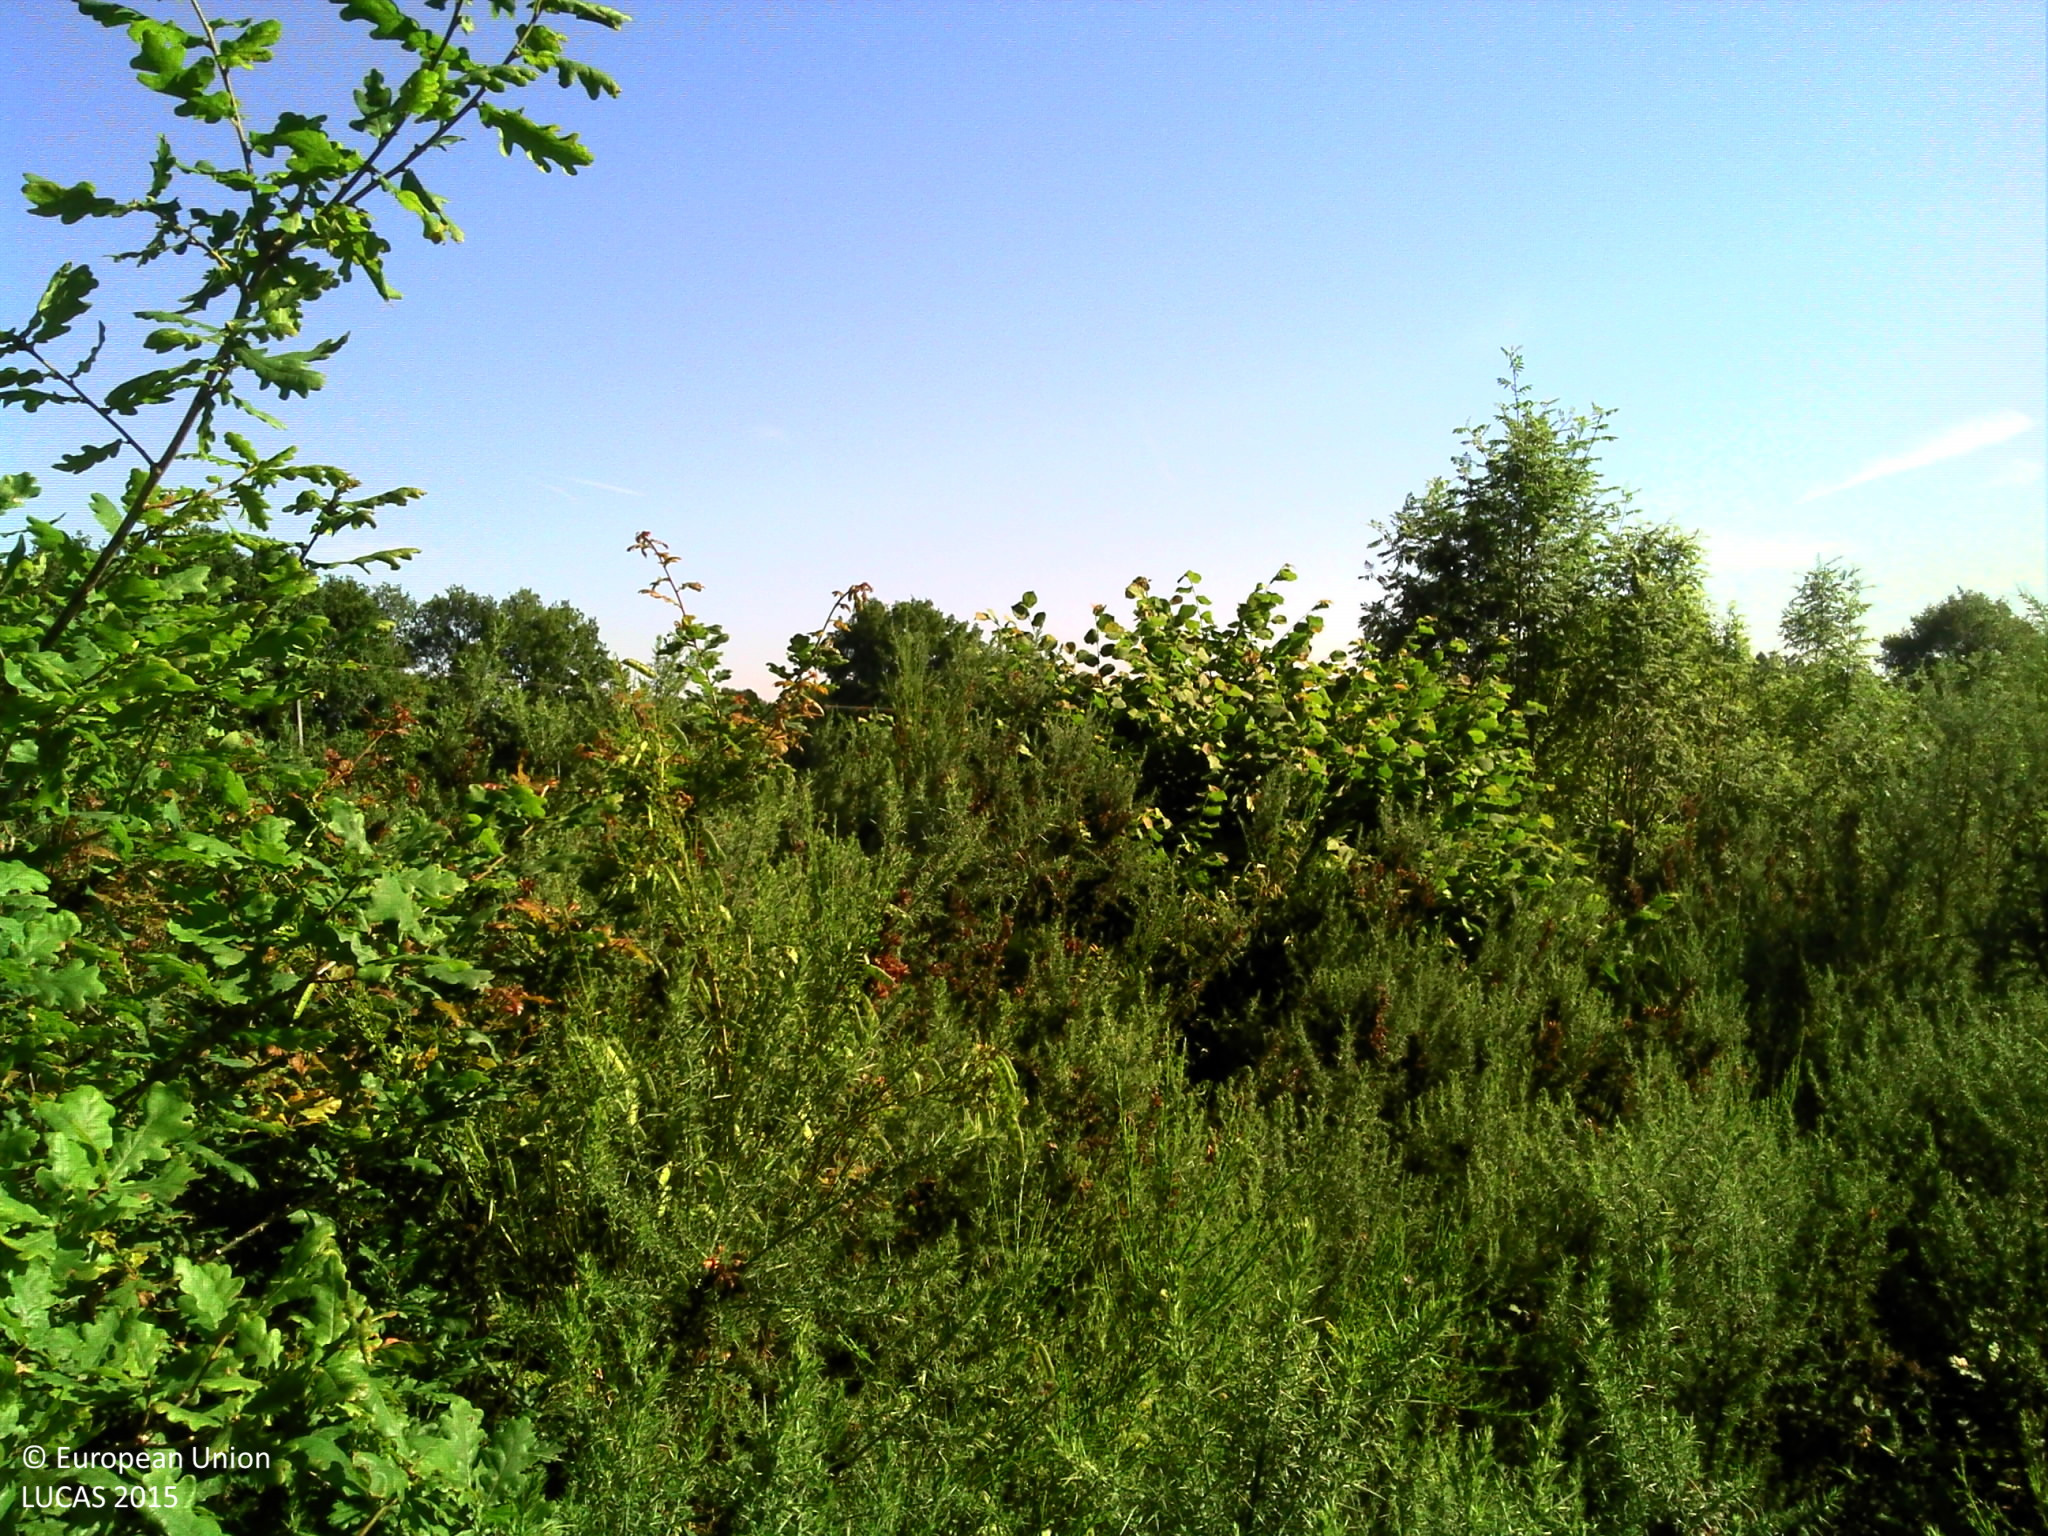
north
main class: Woodland
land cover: Broadleaved woodland
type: thermophilous deciduous forest
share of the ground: > 75 %
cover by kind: shrubs 45 %, broadleaved forest trees 35 %, herbaceous plants 15 %, lichens and mosses 5 %
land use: Semi-natural and natural areas not in use
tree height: > 5 m
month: June
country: FR
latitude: 45.8654
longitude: 0.4139
